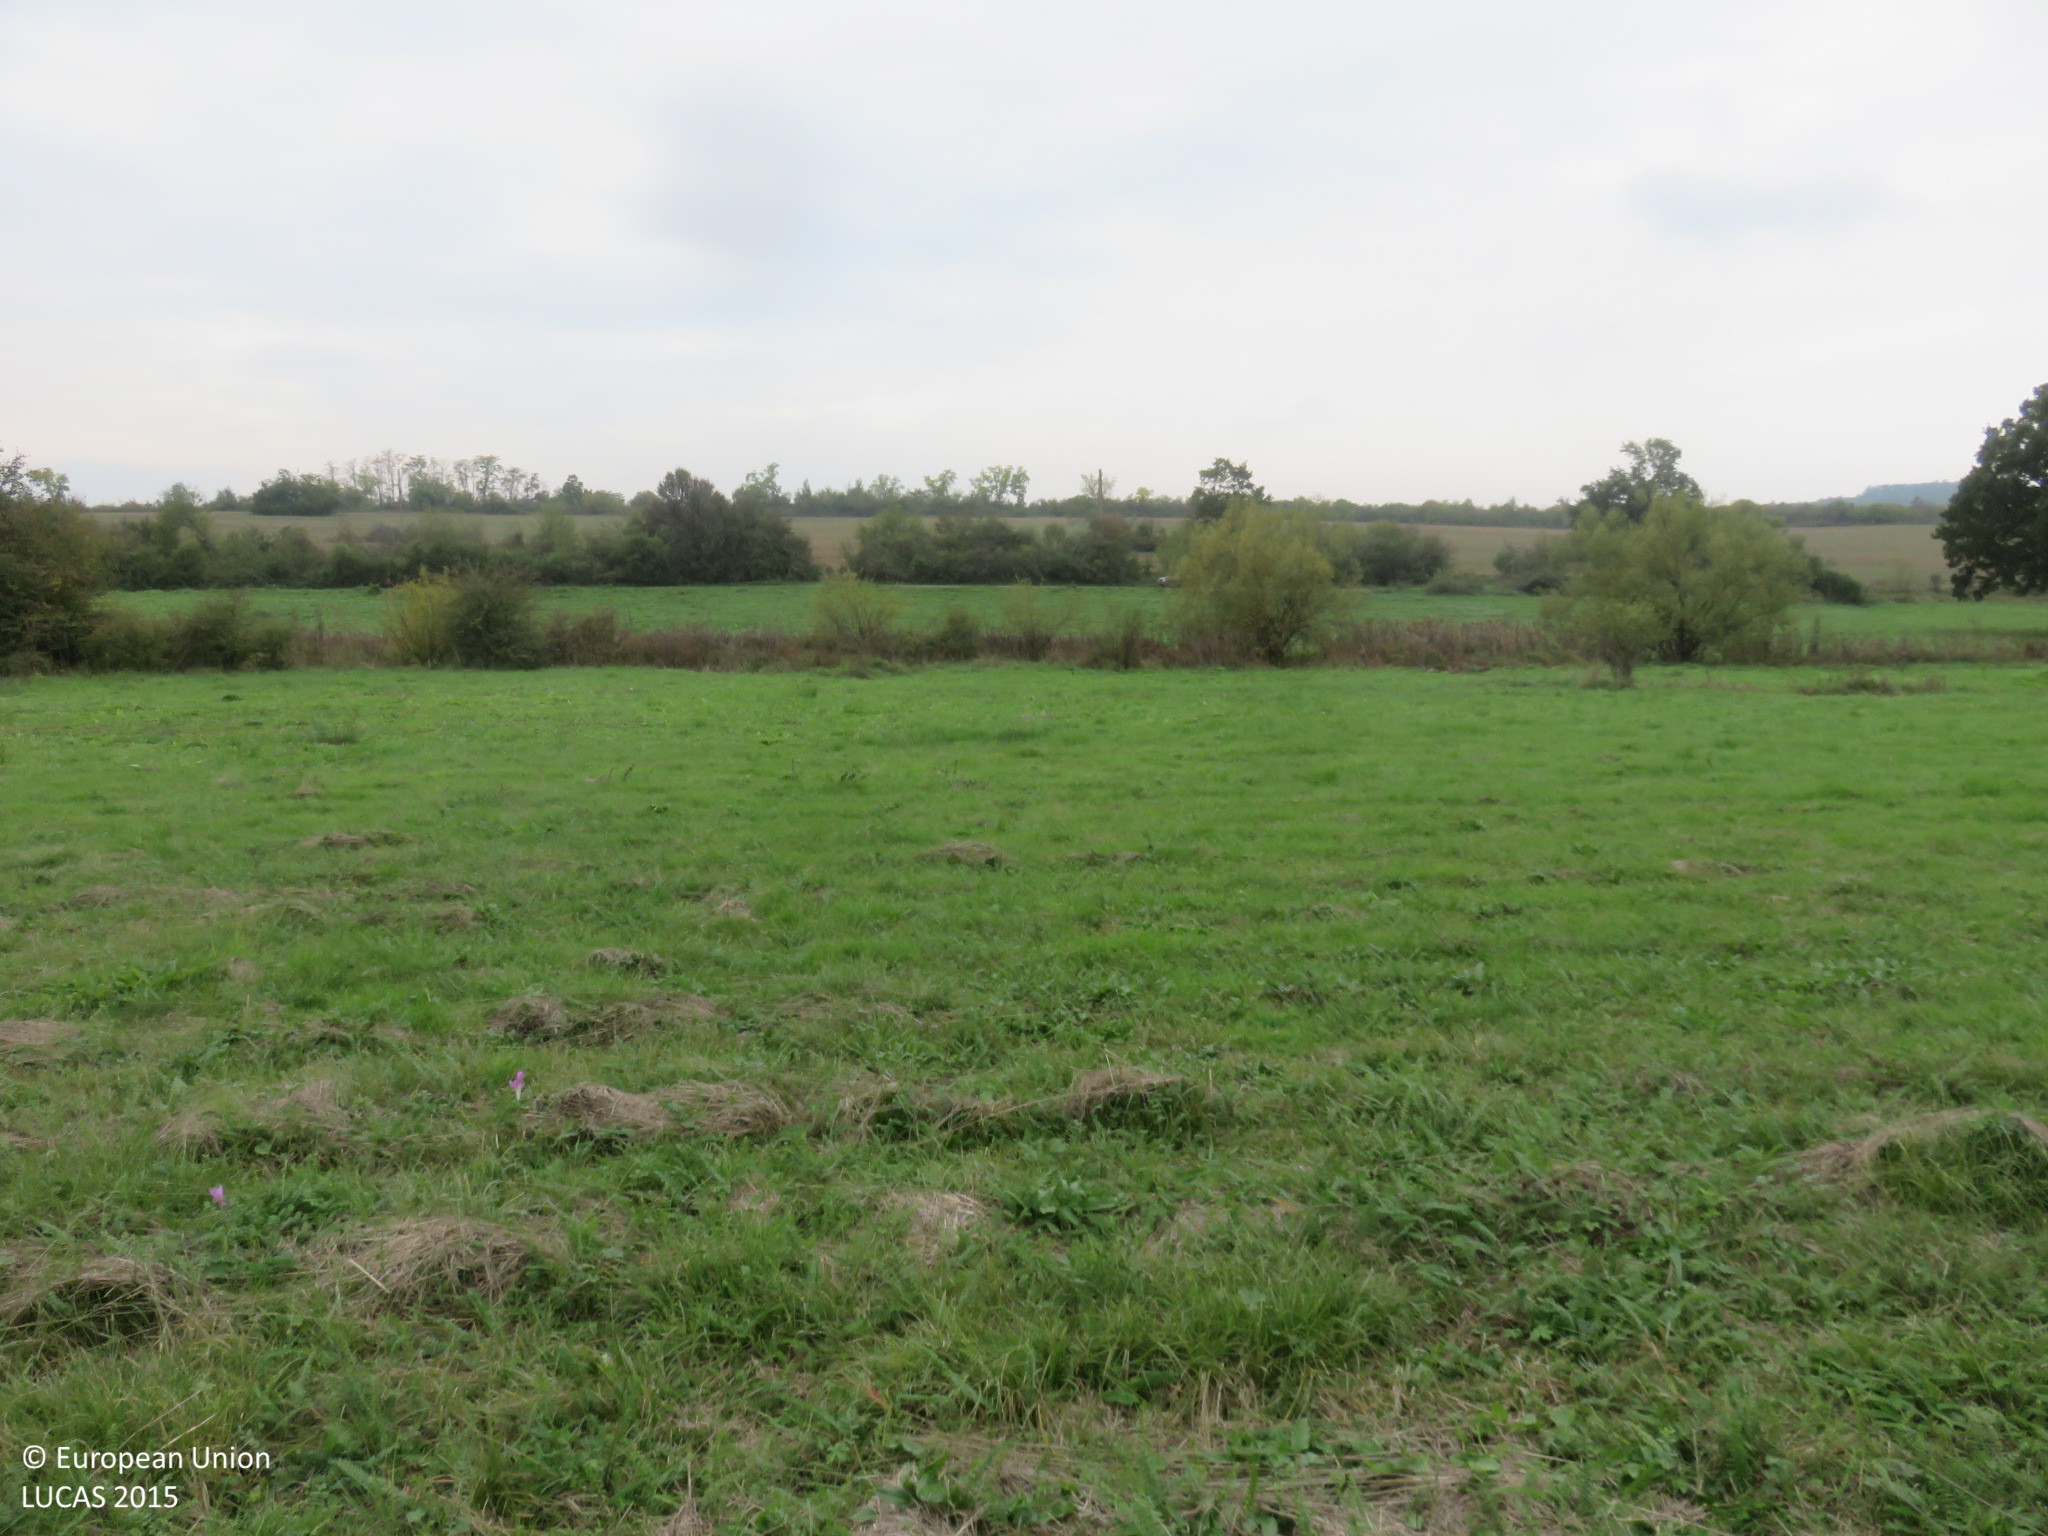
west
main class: Grassland
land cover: Grassland without tree/shrub cover
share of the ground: > 75 %
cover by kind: herbaceous plants 100 %
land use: Agriculture (excluding fallow land and kitchen gardens)
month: October
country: BG
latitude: 42.9720
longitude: 25.1623
